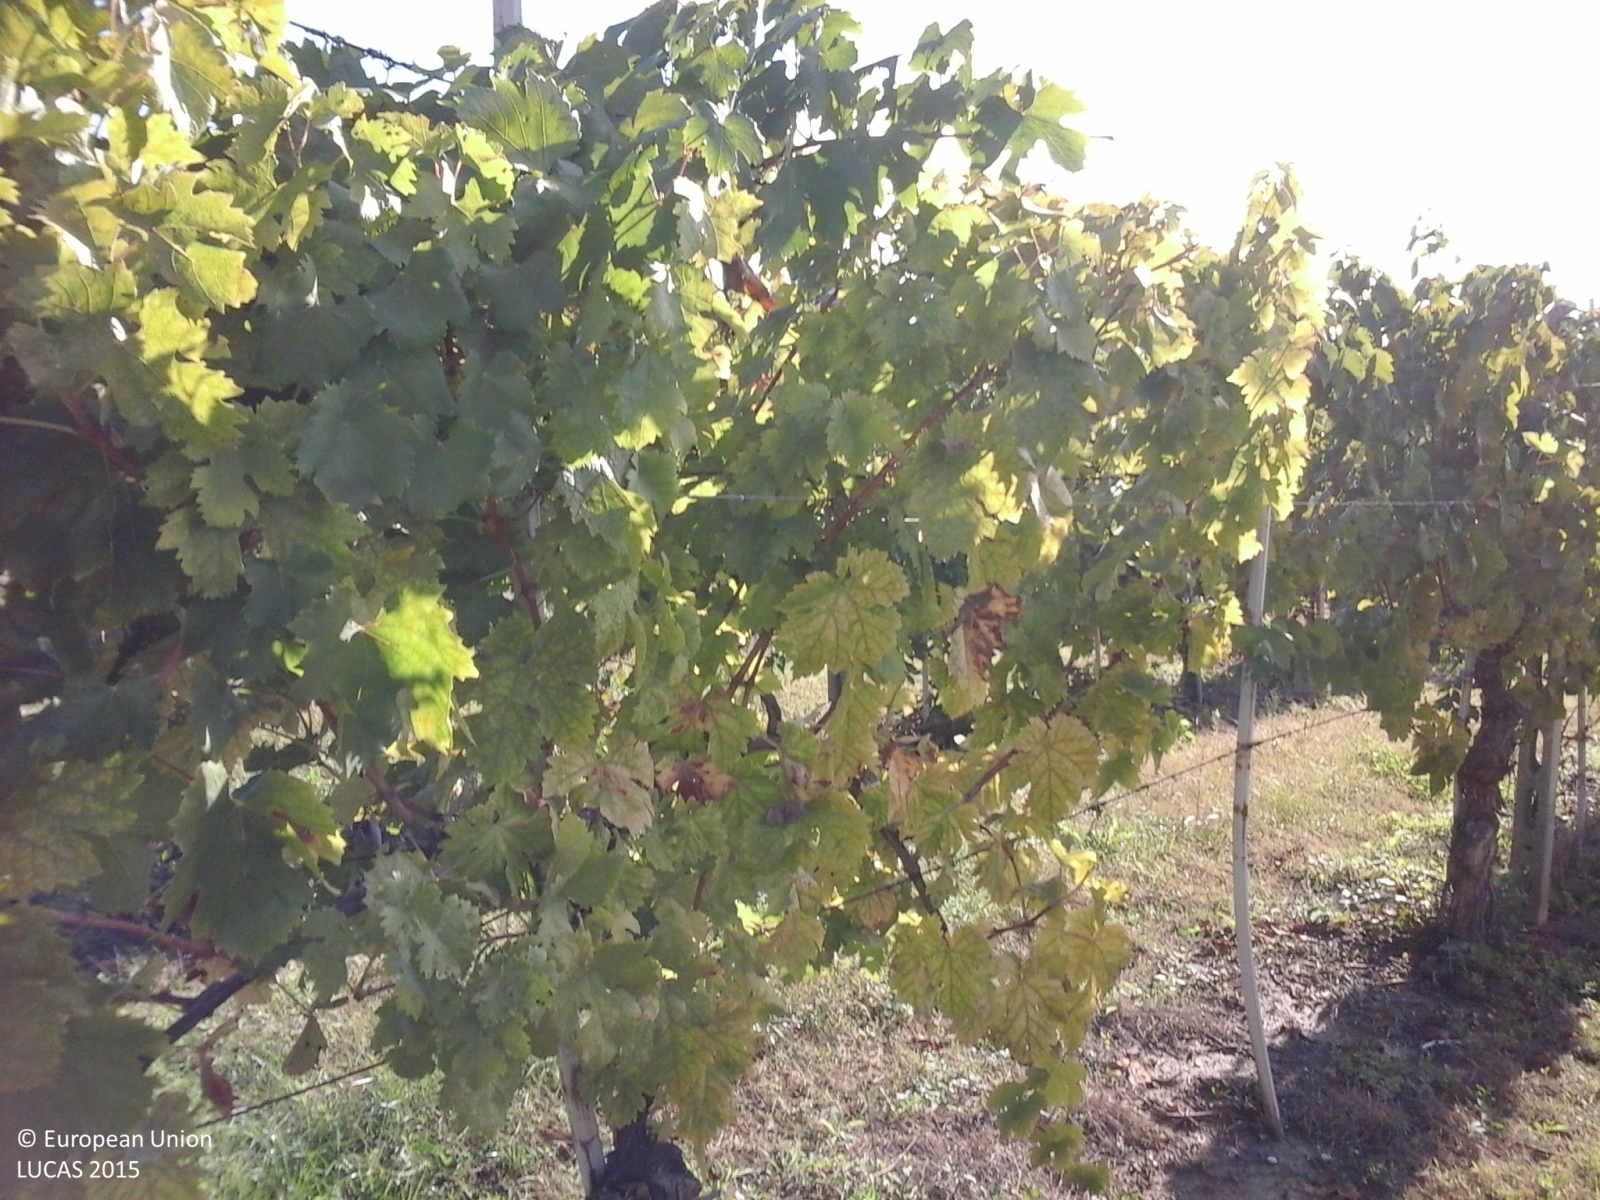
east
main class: Cropland
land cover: Vineyards
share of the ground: 50 - 75 %
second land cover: Grassland without tree/shrub cover
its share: > 75 %
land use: Agriculture (excluding fallow land and kitchen gardens)
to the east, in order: Vineyards; Grassland without tree/shrub cover; Broadleaved woodland; Olive groves; Durum wheat
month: October
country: IT
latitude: 43.6692
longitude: 13.2045
